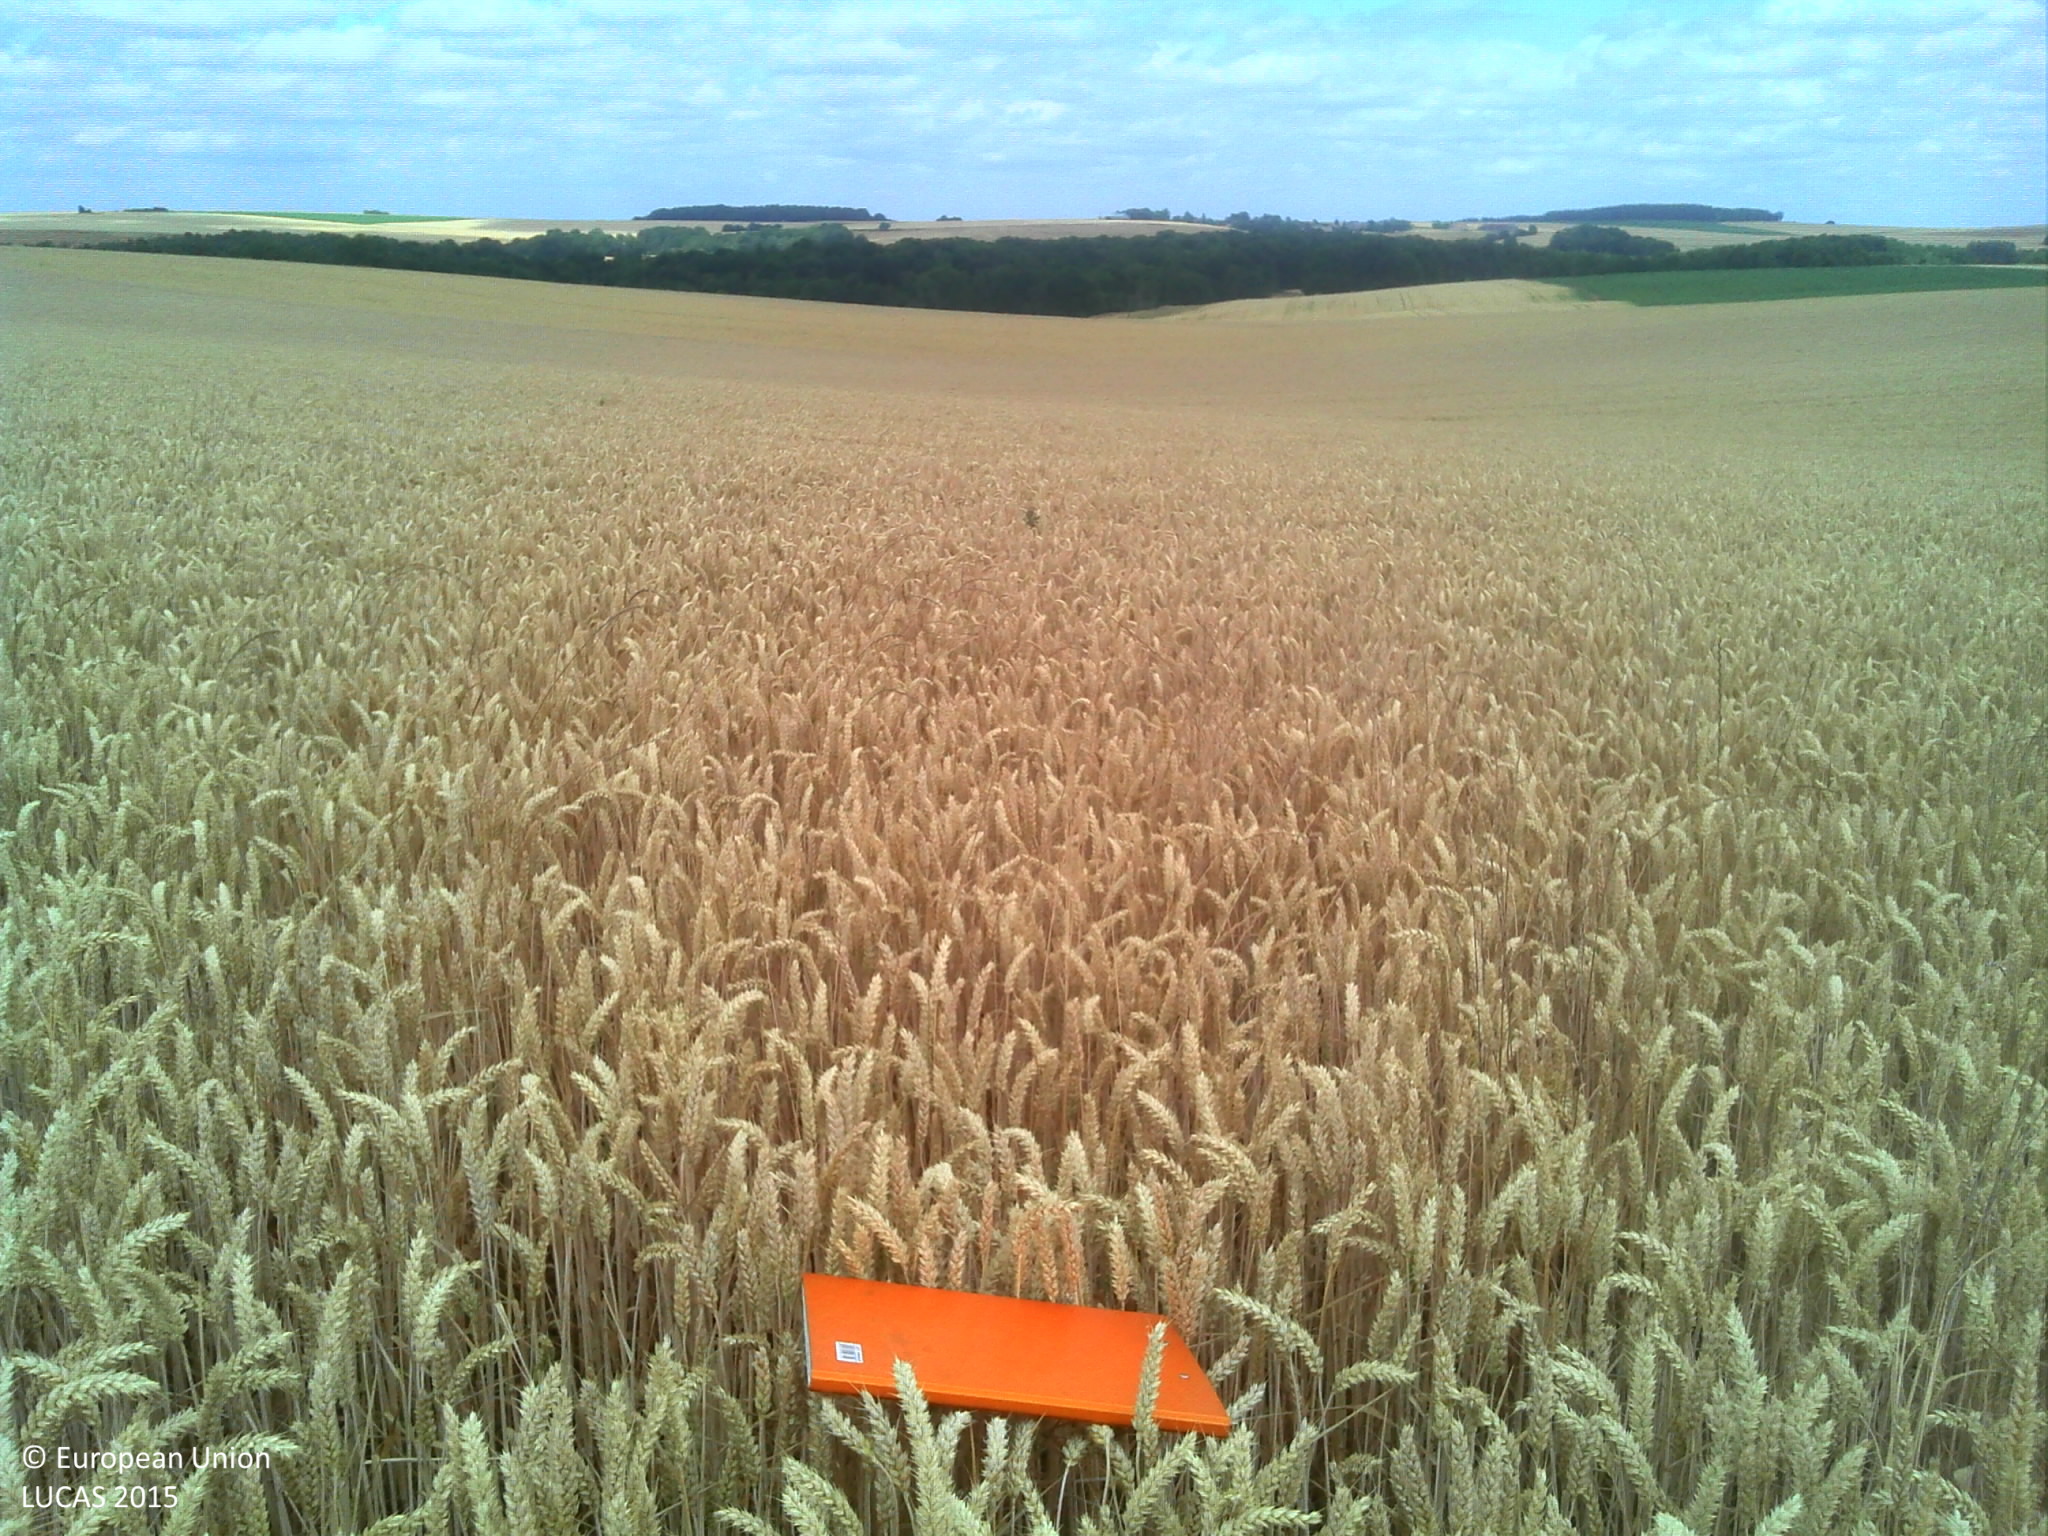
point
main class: Cropland
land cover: Common wheat
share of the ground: > 75 %
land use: Agriculture (excluding fallow land and kitchen gardens)
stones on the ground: < 10 %
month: July
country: FR
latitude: 49.2278
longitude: 3.2773
